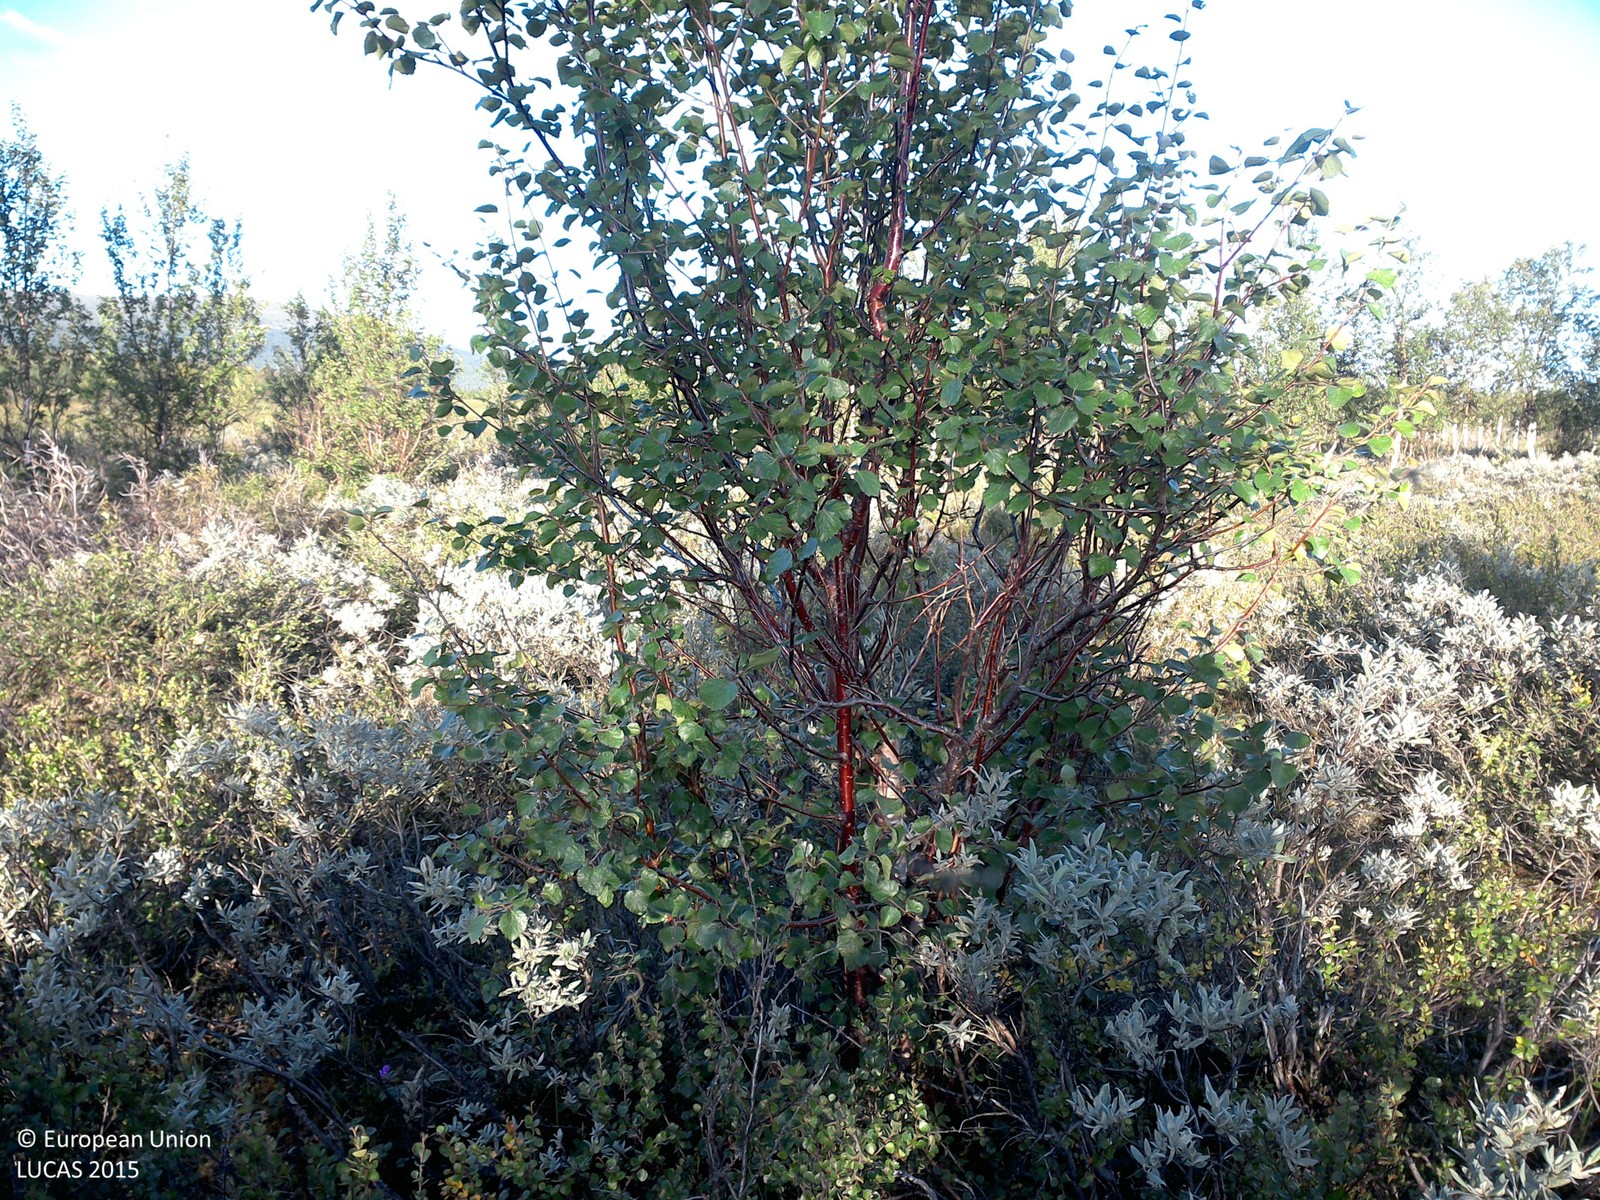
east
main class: Shrubland
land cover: Shrubland with sparse tree cover
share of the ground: > 75 %
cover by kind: shrubs 95 %, broadleaved forest trees 5 %
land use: Semi-natural and natural areas not in use
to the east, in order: Shrubland with sparse tree cover; Broadleaved woodland; Shrubland without tree cover; Broadleaved woodland; Shrubland with sparse tree cover
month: August
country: SE
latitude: 67.8599
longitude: 19.3770
